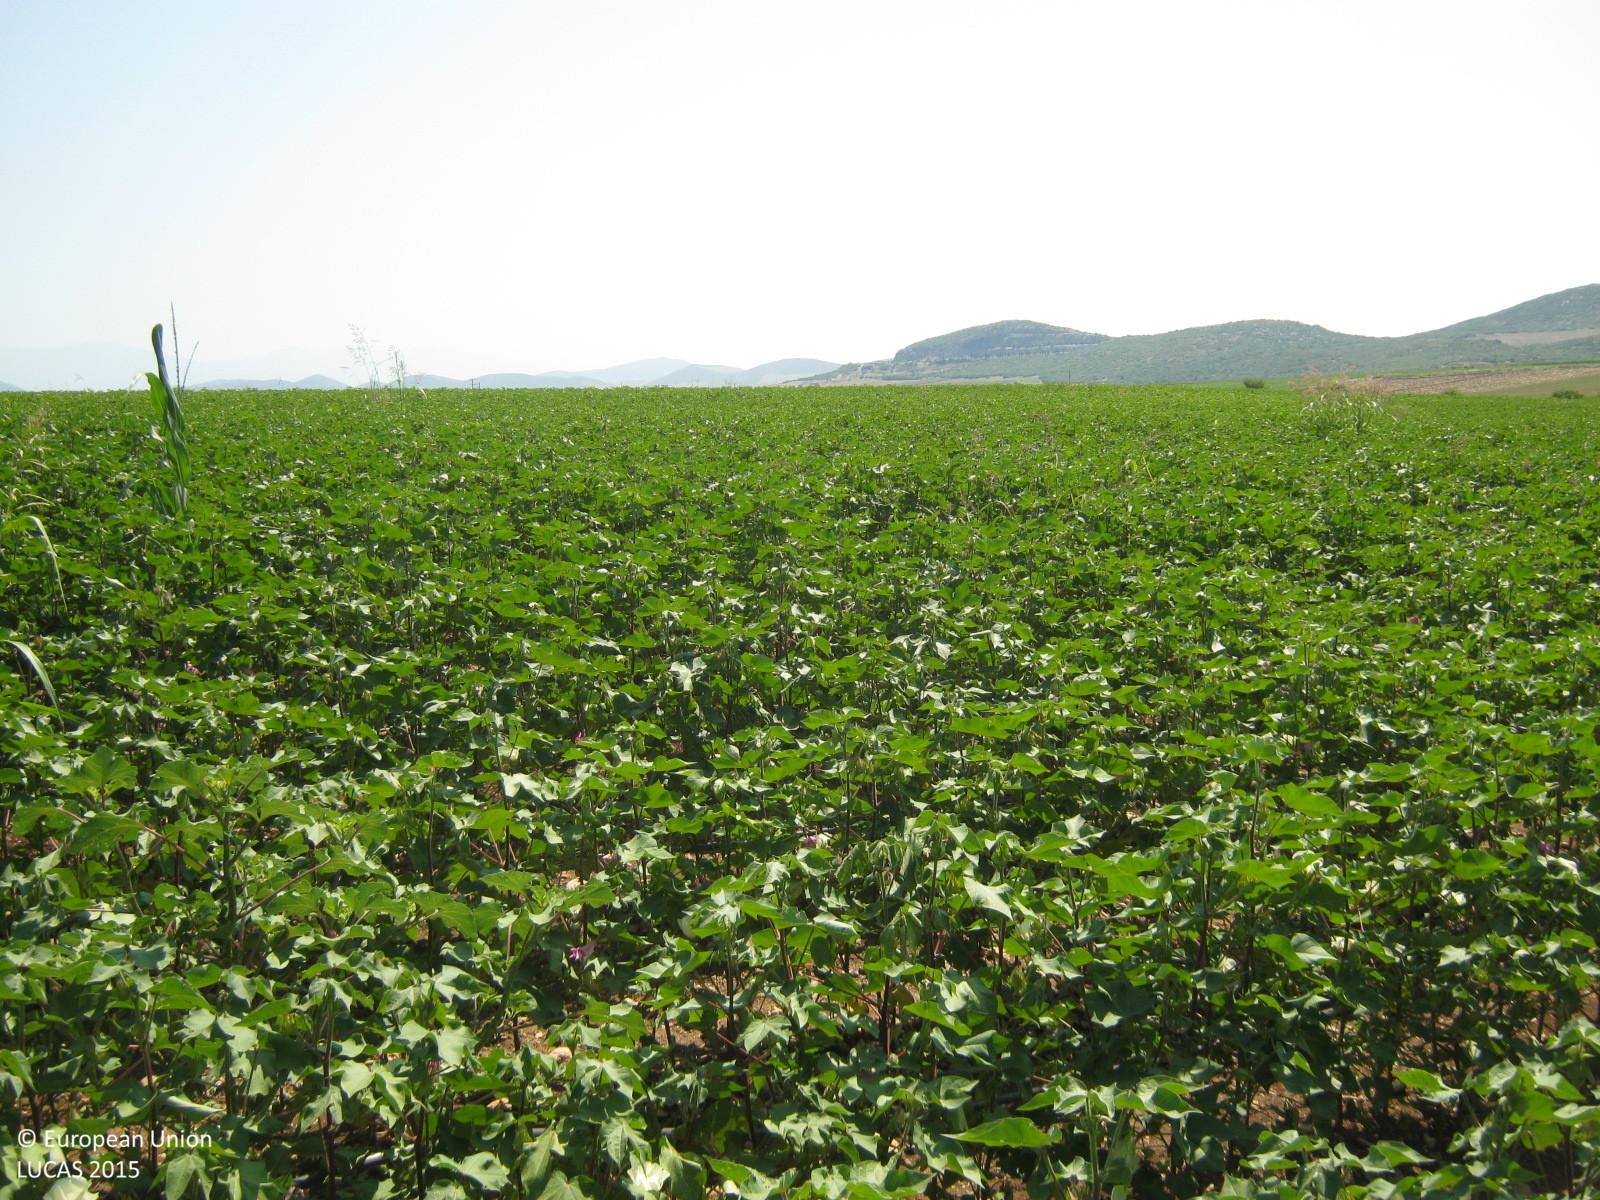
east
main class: Cropland
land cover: Cotton
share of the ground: > 75 %
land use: Agriculture (excluding fallow land and kitchen gardens)
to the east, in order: Cotton; Common wheat
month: July
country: GR
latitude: 39.3089
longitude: 22.7106
